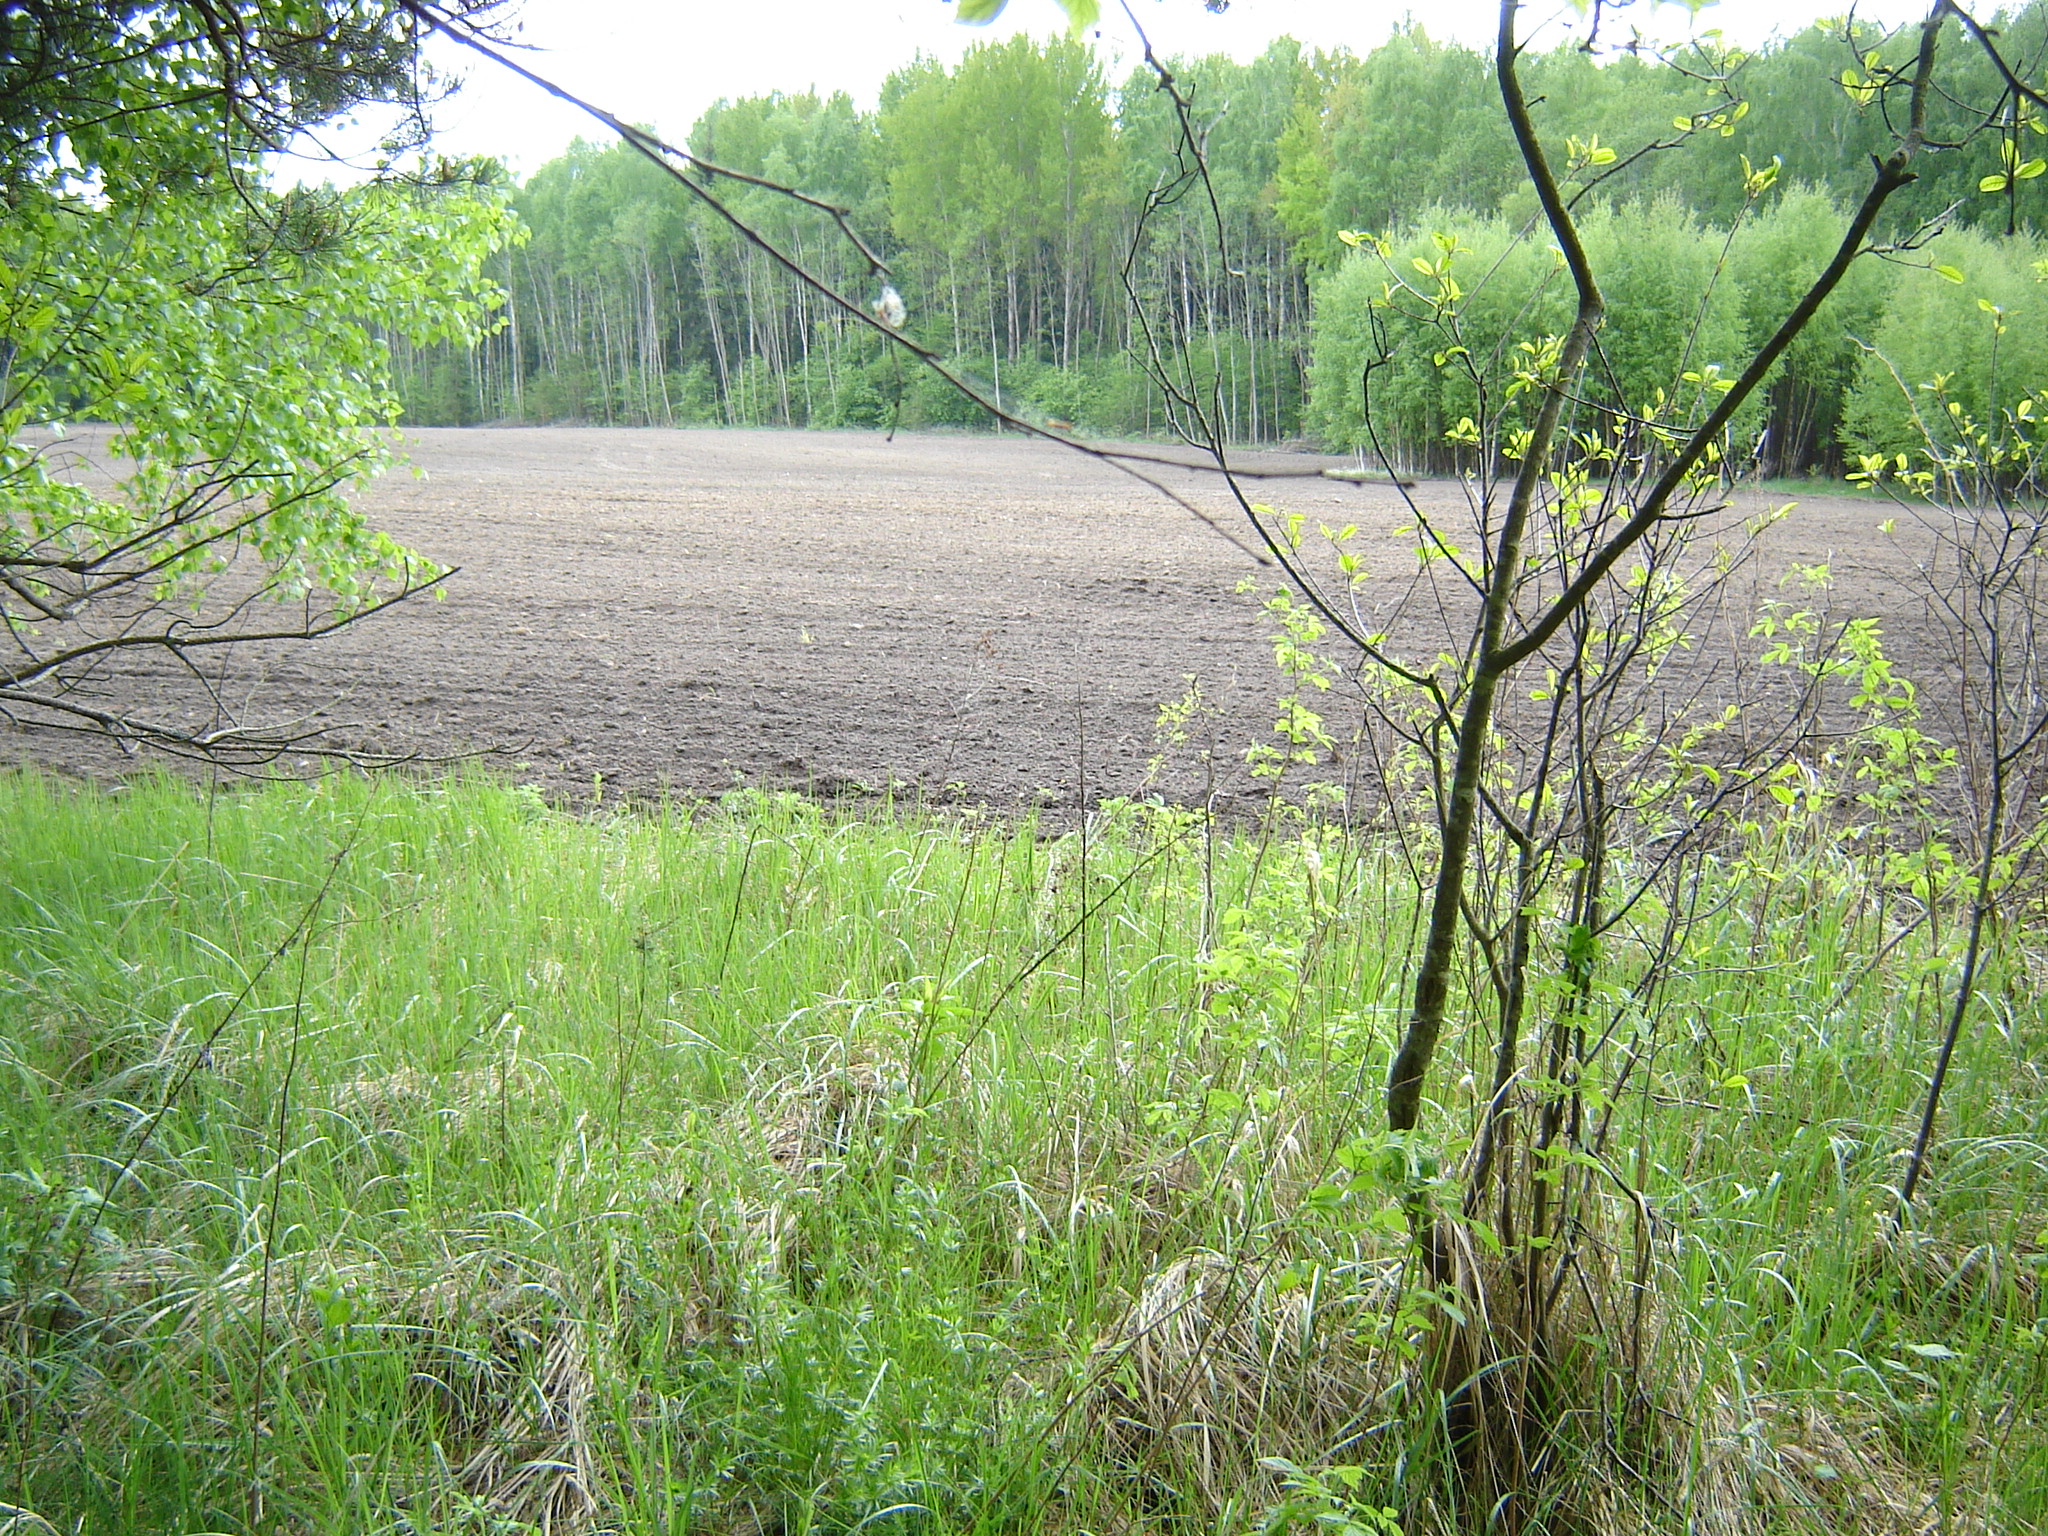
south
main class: Woodland
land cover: Broadleaved woodland
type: non-riverine alder, birch or aspen forest
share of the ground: > 75 %
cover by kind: broadleaved forest trees 80 %, herbaceous plants 10 %, coniferous forest trees 5 %, shrubs 5 %
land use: Forestry
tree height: > 5 m
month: May
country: LT
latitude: 56.1008
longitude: 25.3425
